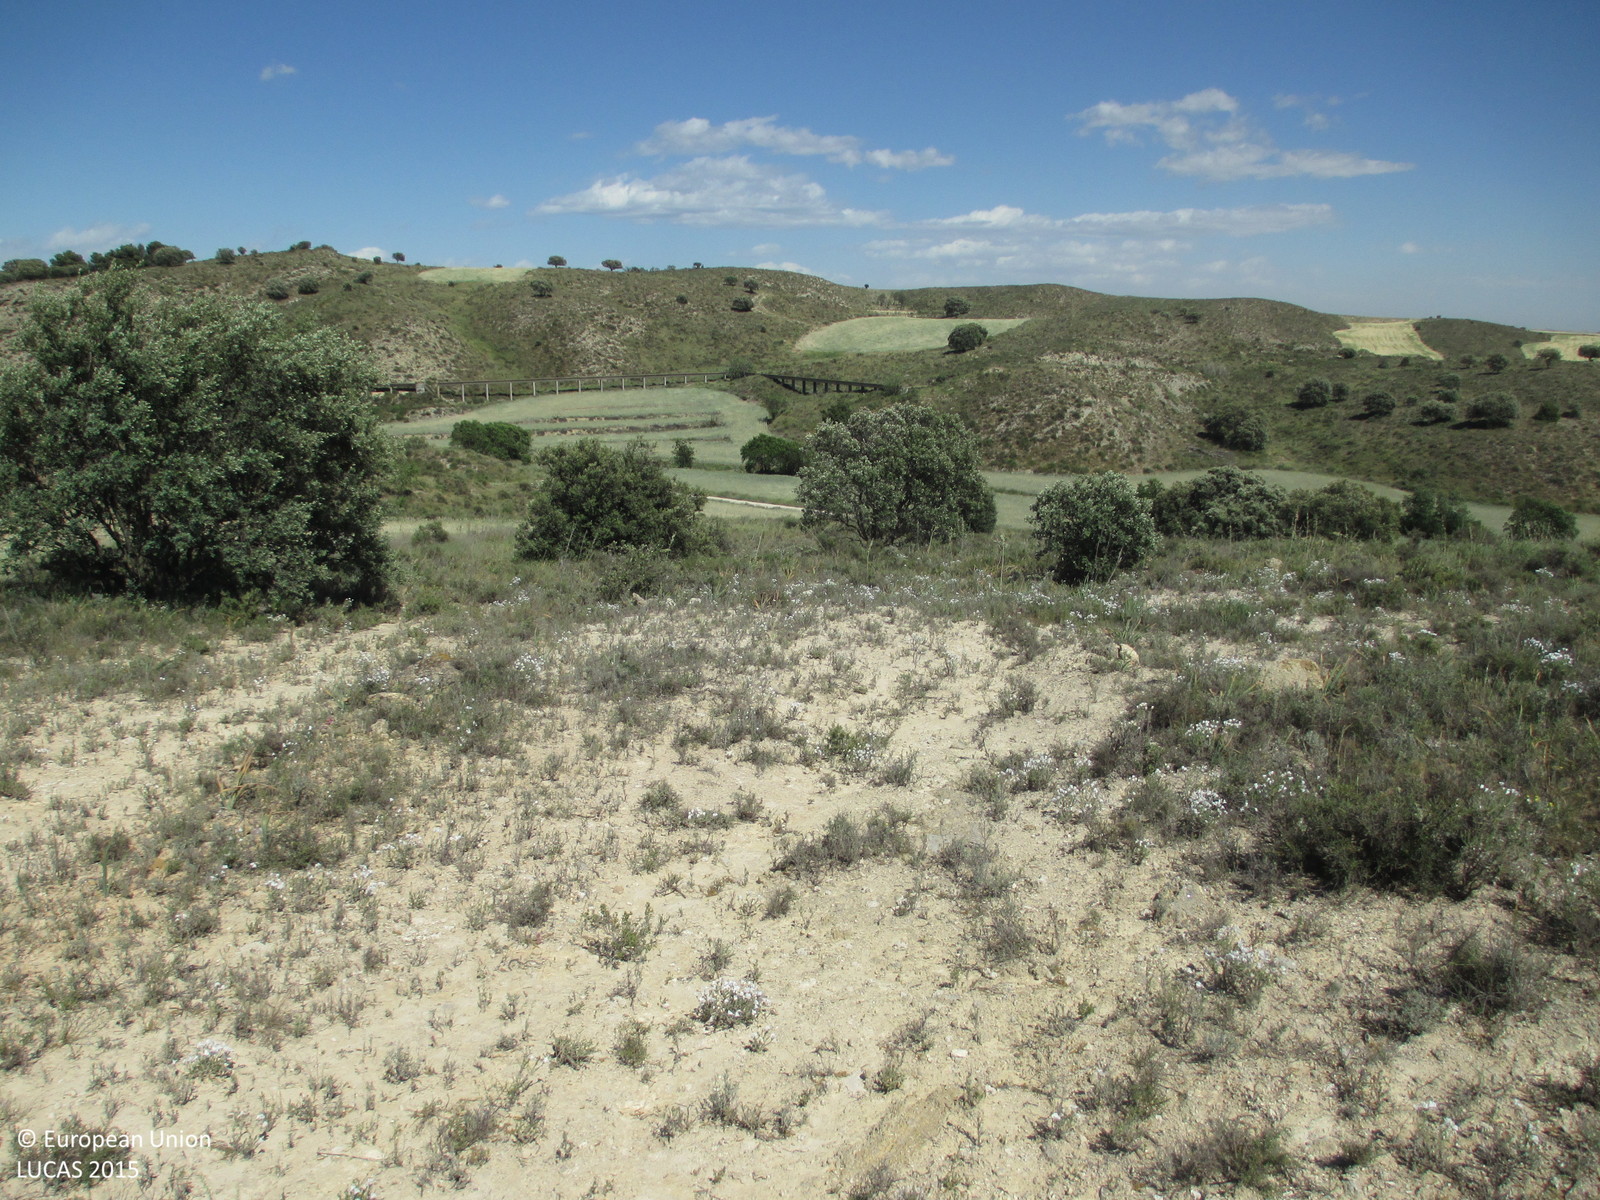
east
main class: Shrubland
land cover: Shrubland with sparse tree cover
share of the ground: > 75 %
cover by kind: shrubs 85 %, broadleaved forest trees 5 %, herbaceous plants 5 %, unconsolidated bare surface 5 %
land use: Semi-natural and natural areas not in use
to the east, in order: Shrubland with sparse tree cover; Shrubland without tree cover; Common wheat; Shruby margins; Tracks; Shruby margins; Common wheat; Single bushes/trees; Shruby margins; Ditches and canals; Shruby margins; Common wheat; Shrubland with sparse tree cover
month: May
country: ES
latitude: 41.9857
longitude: 0.0966
